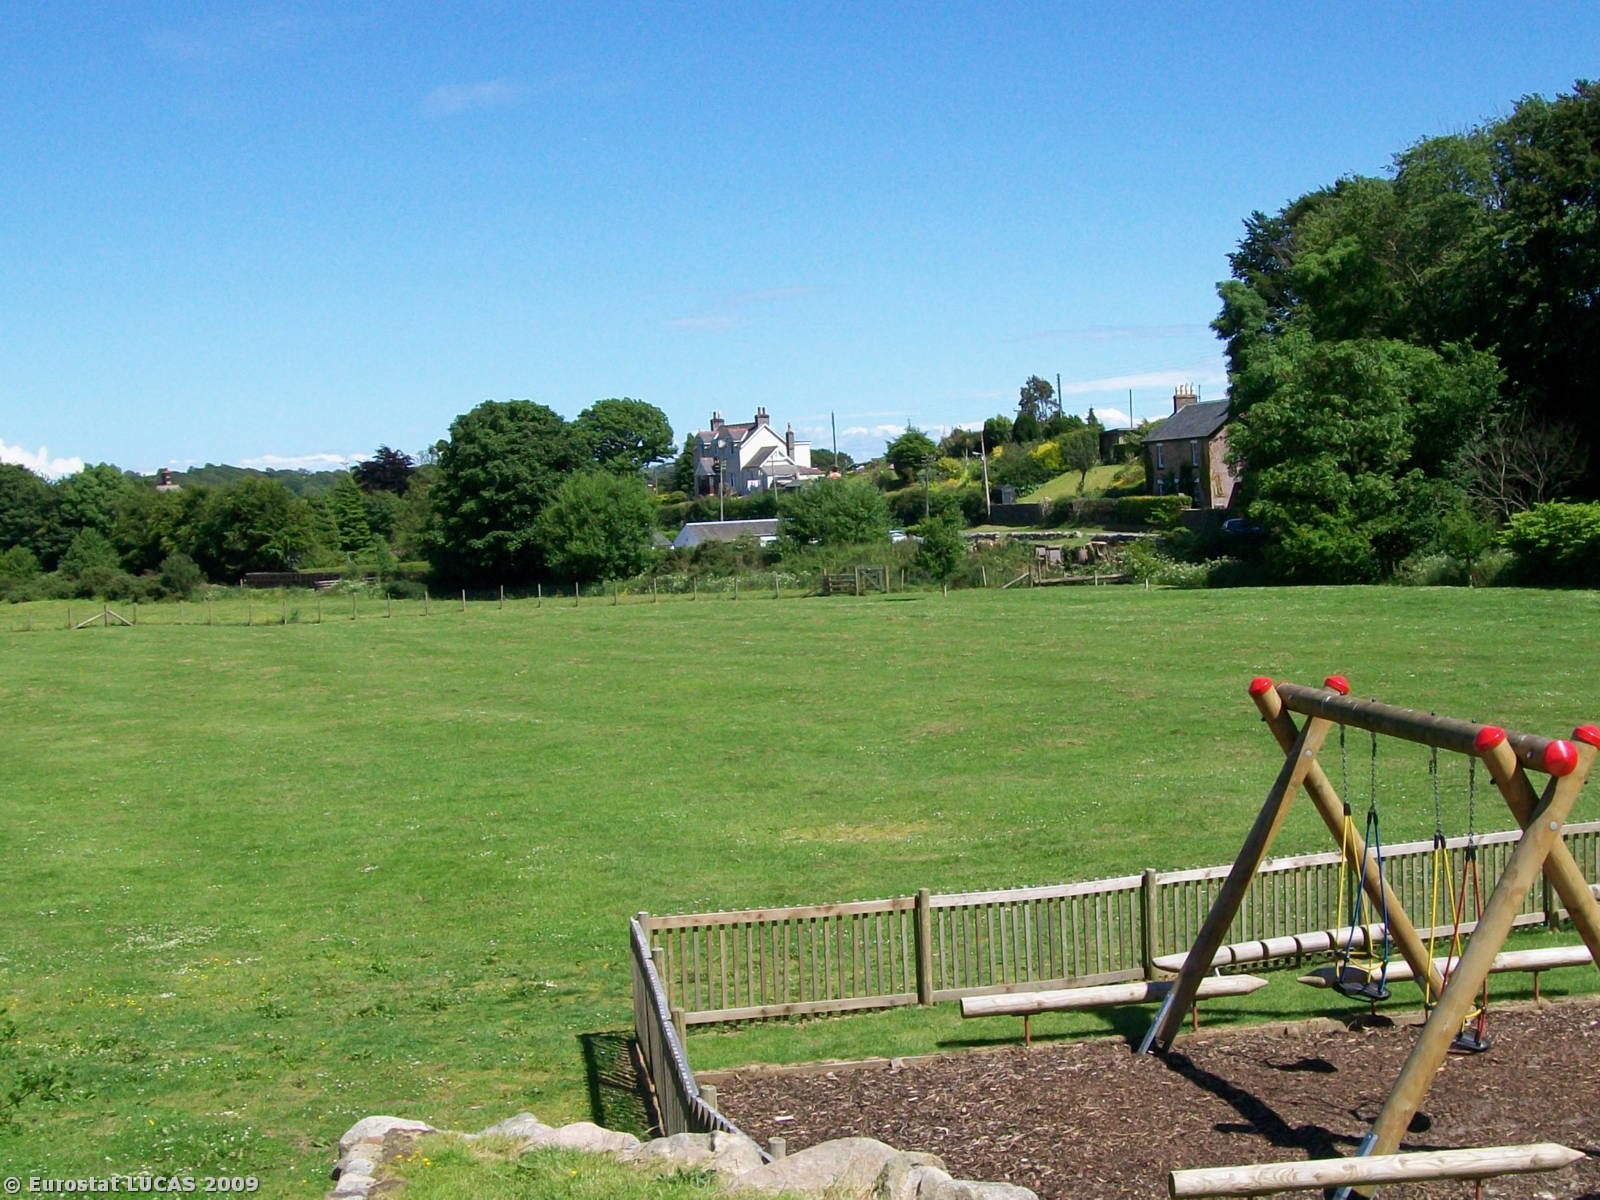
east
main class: Grassland
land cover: Grassland with sparse tree/shrub cover
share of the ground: > 75 %
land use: Amenities, museums, leisure
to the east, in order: Grassland with sparse tree/shrub cover; Artificial constructions; Grassland with sparse tree/shrub cover; Artificial constructions; Fences; Grassland without tree/shrub cover; Grassland with sparse tree/shrub cover; Fences; Shrubland with sparse tree cover; Inland running water; Shrubland with sparse tree cover; Managed hedges; Artificial constructions in urban areas; Grass margins; Paved roads, cycling and walking lanes; Grass margins; Artificial constructions in urban areas
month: June
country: GB
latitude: 54.8447
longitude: -3.8705
